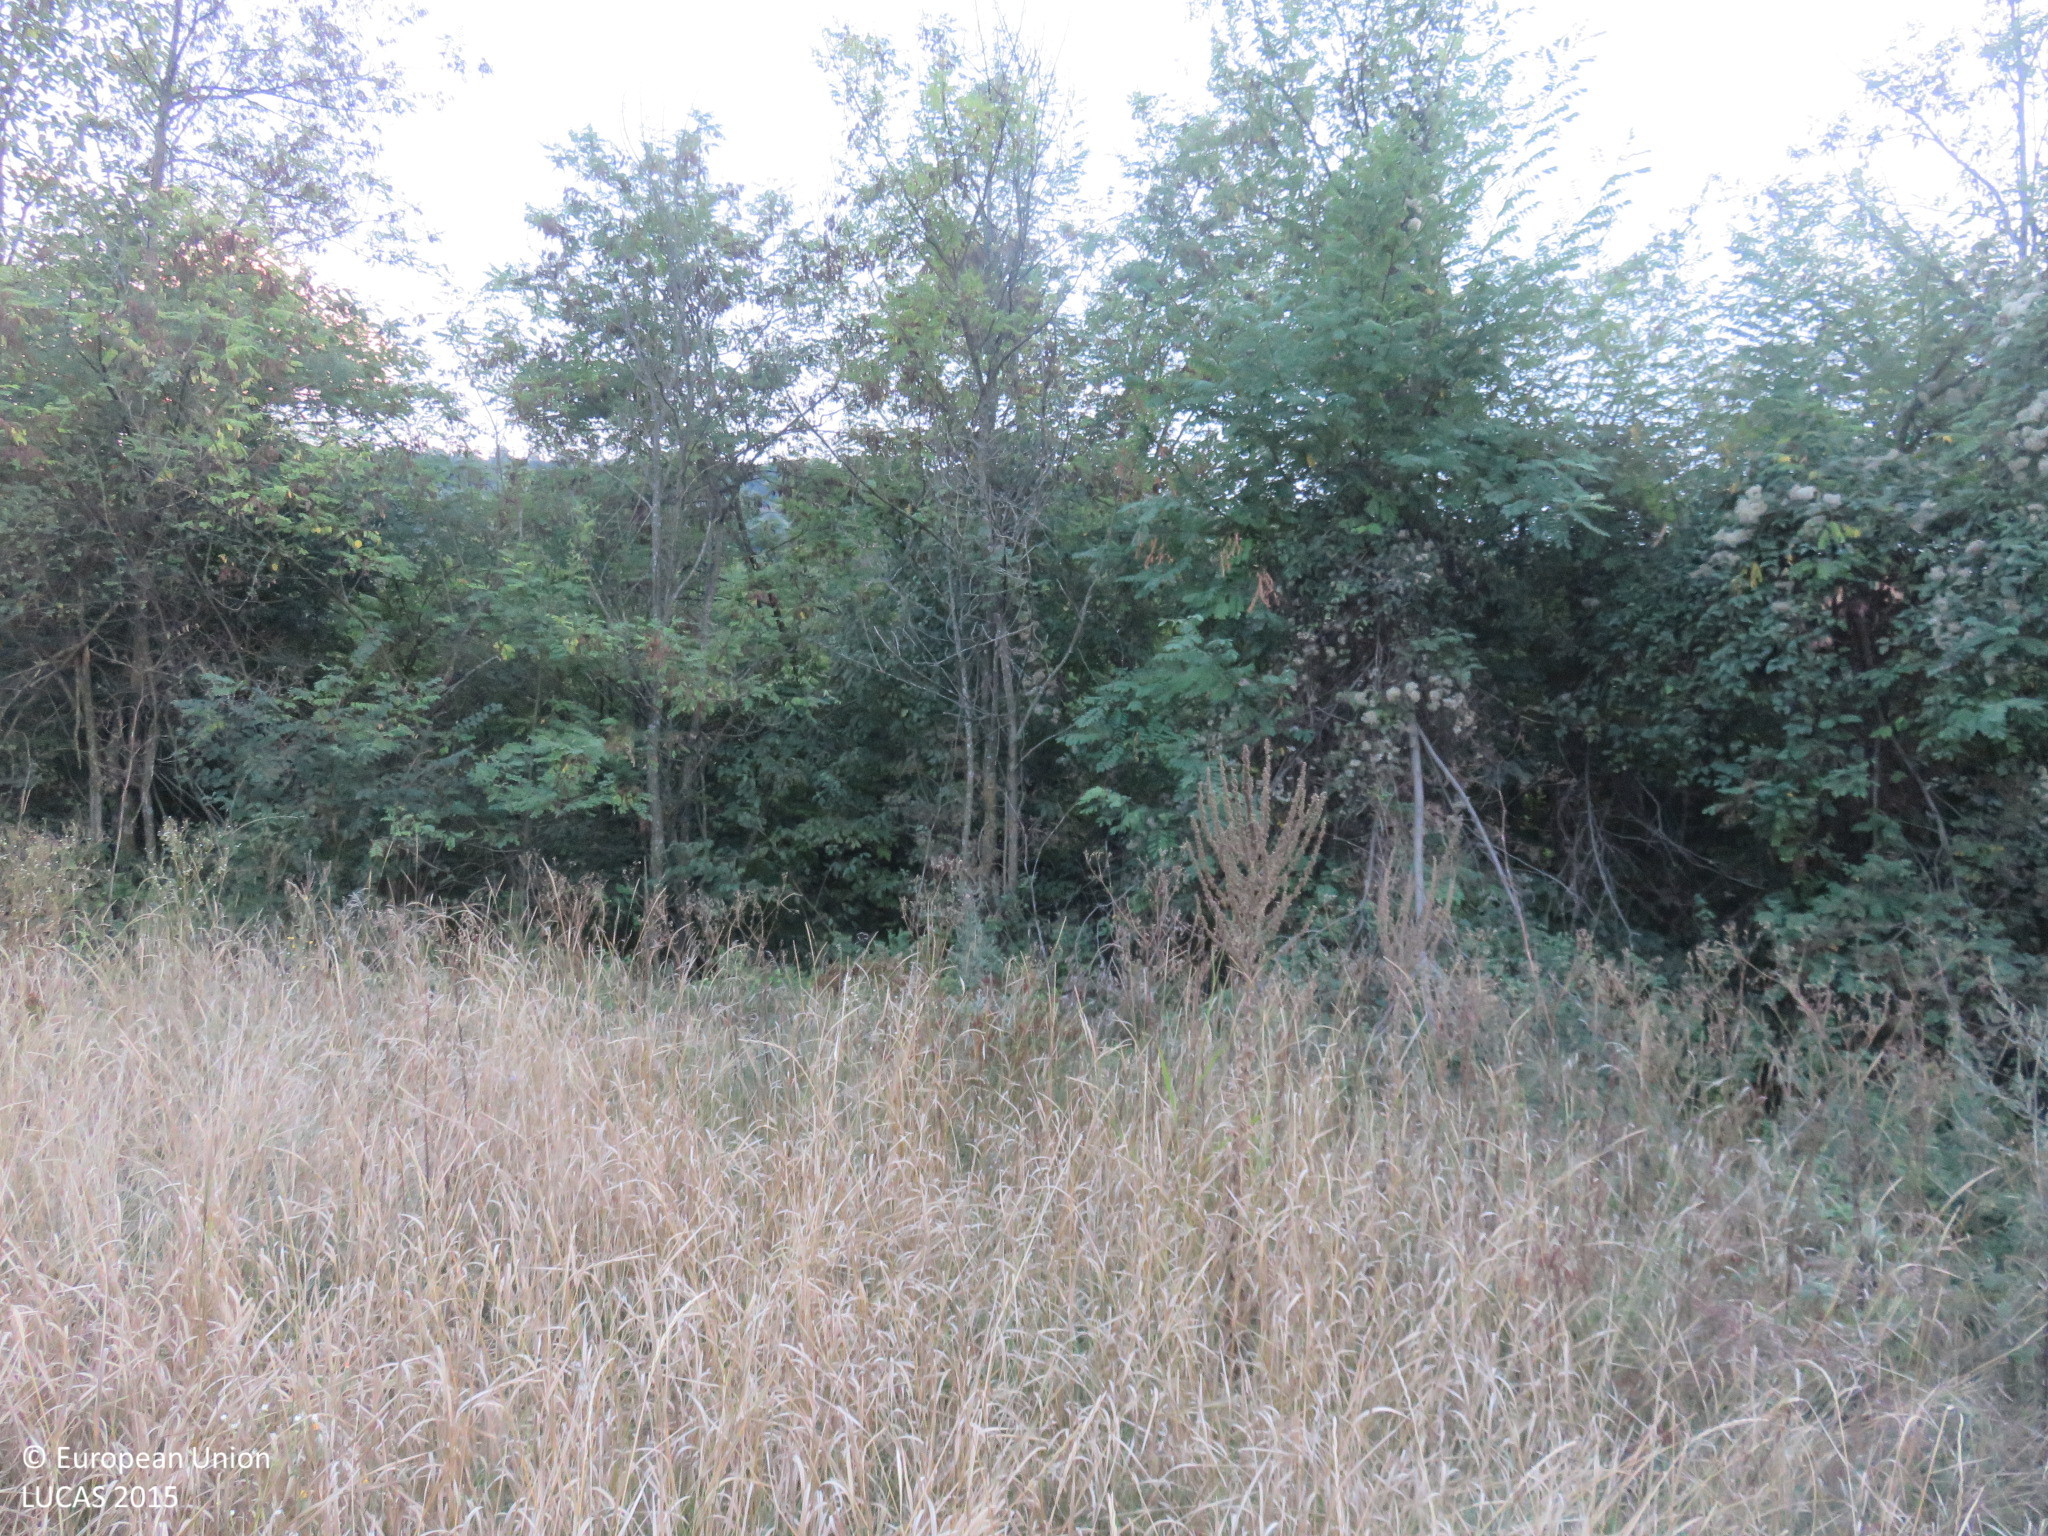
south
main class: Grassland
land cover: Grassland without tree/shrub cover
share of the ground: > 75 %
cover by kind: herbaceous plants 100 %
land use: Agriculture (excluding fallow land and kitchen gardens)
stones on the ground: < 10 %
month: September
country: BG
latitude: 43.1246
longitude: 24.8762
